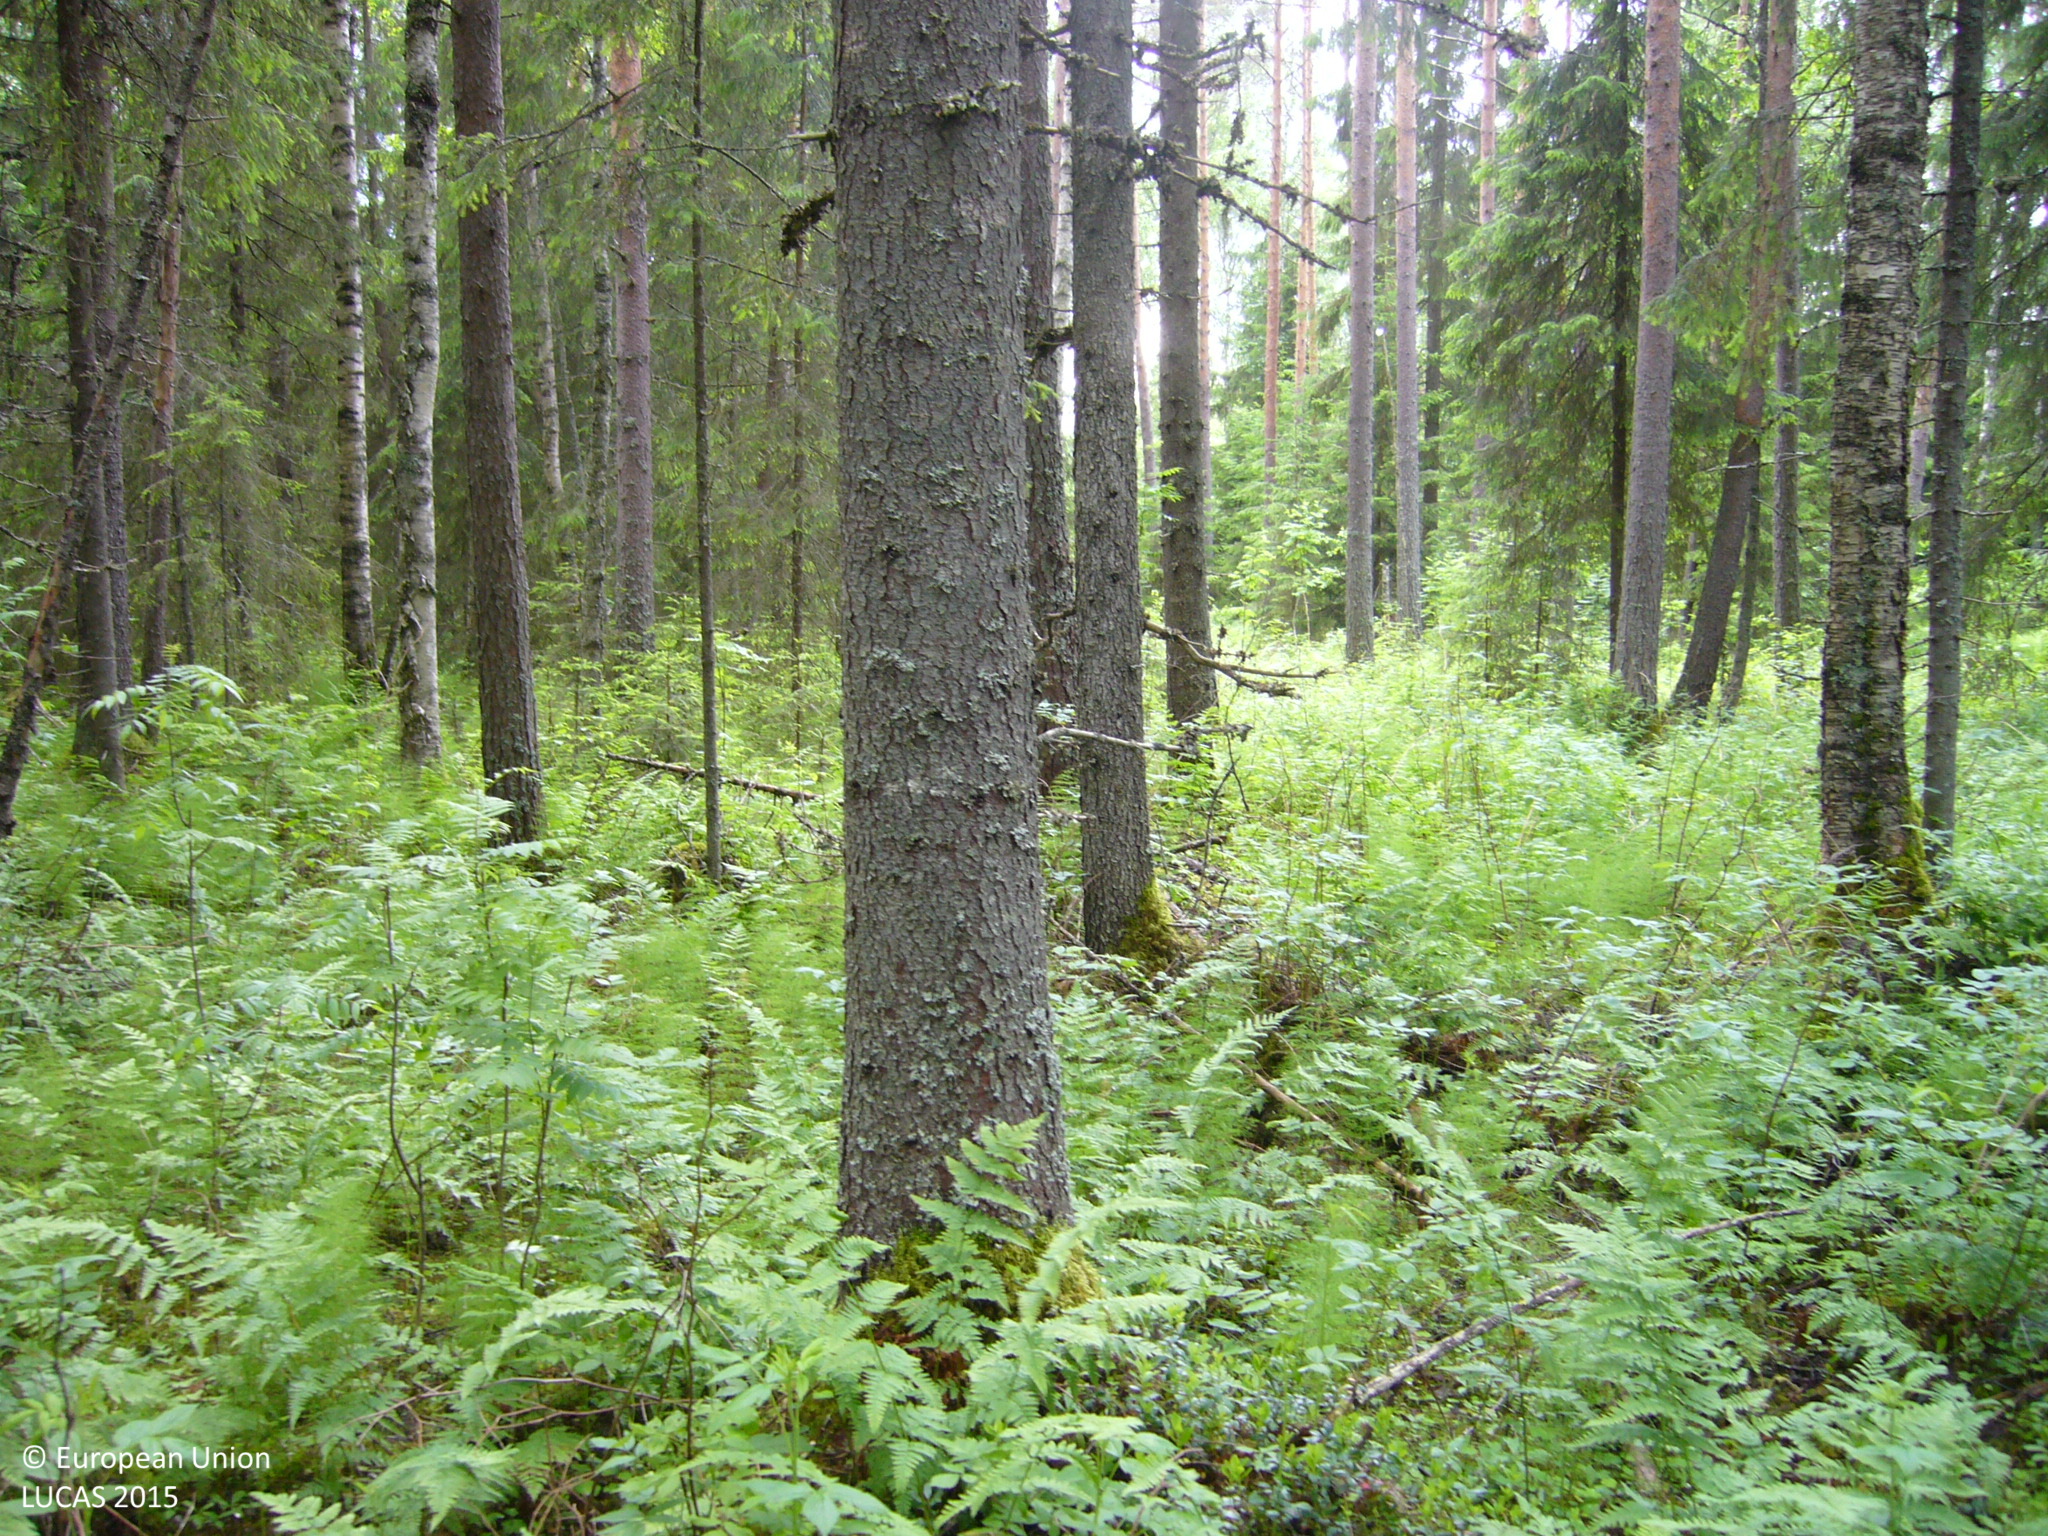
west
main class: Woodland
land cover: Spruce dominated coniferous woodland
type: boreal forest
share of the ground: > 75 %
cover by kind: coniferous forest trees 80 %, broadleaved forest trees 10 %, shrubs 10 %
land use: Forestry
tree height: > 5 m
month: June
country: FI
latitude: 63.7060
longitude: 26.3683
